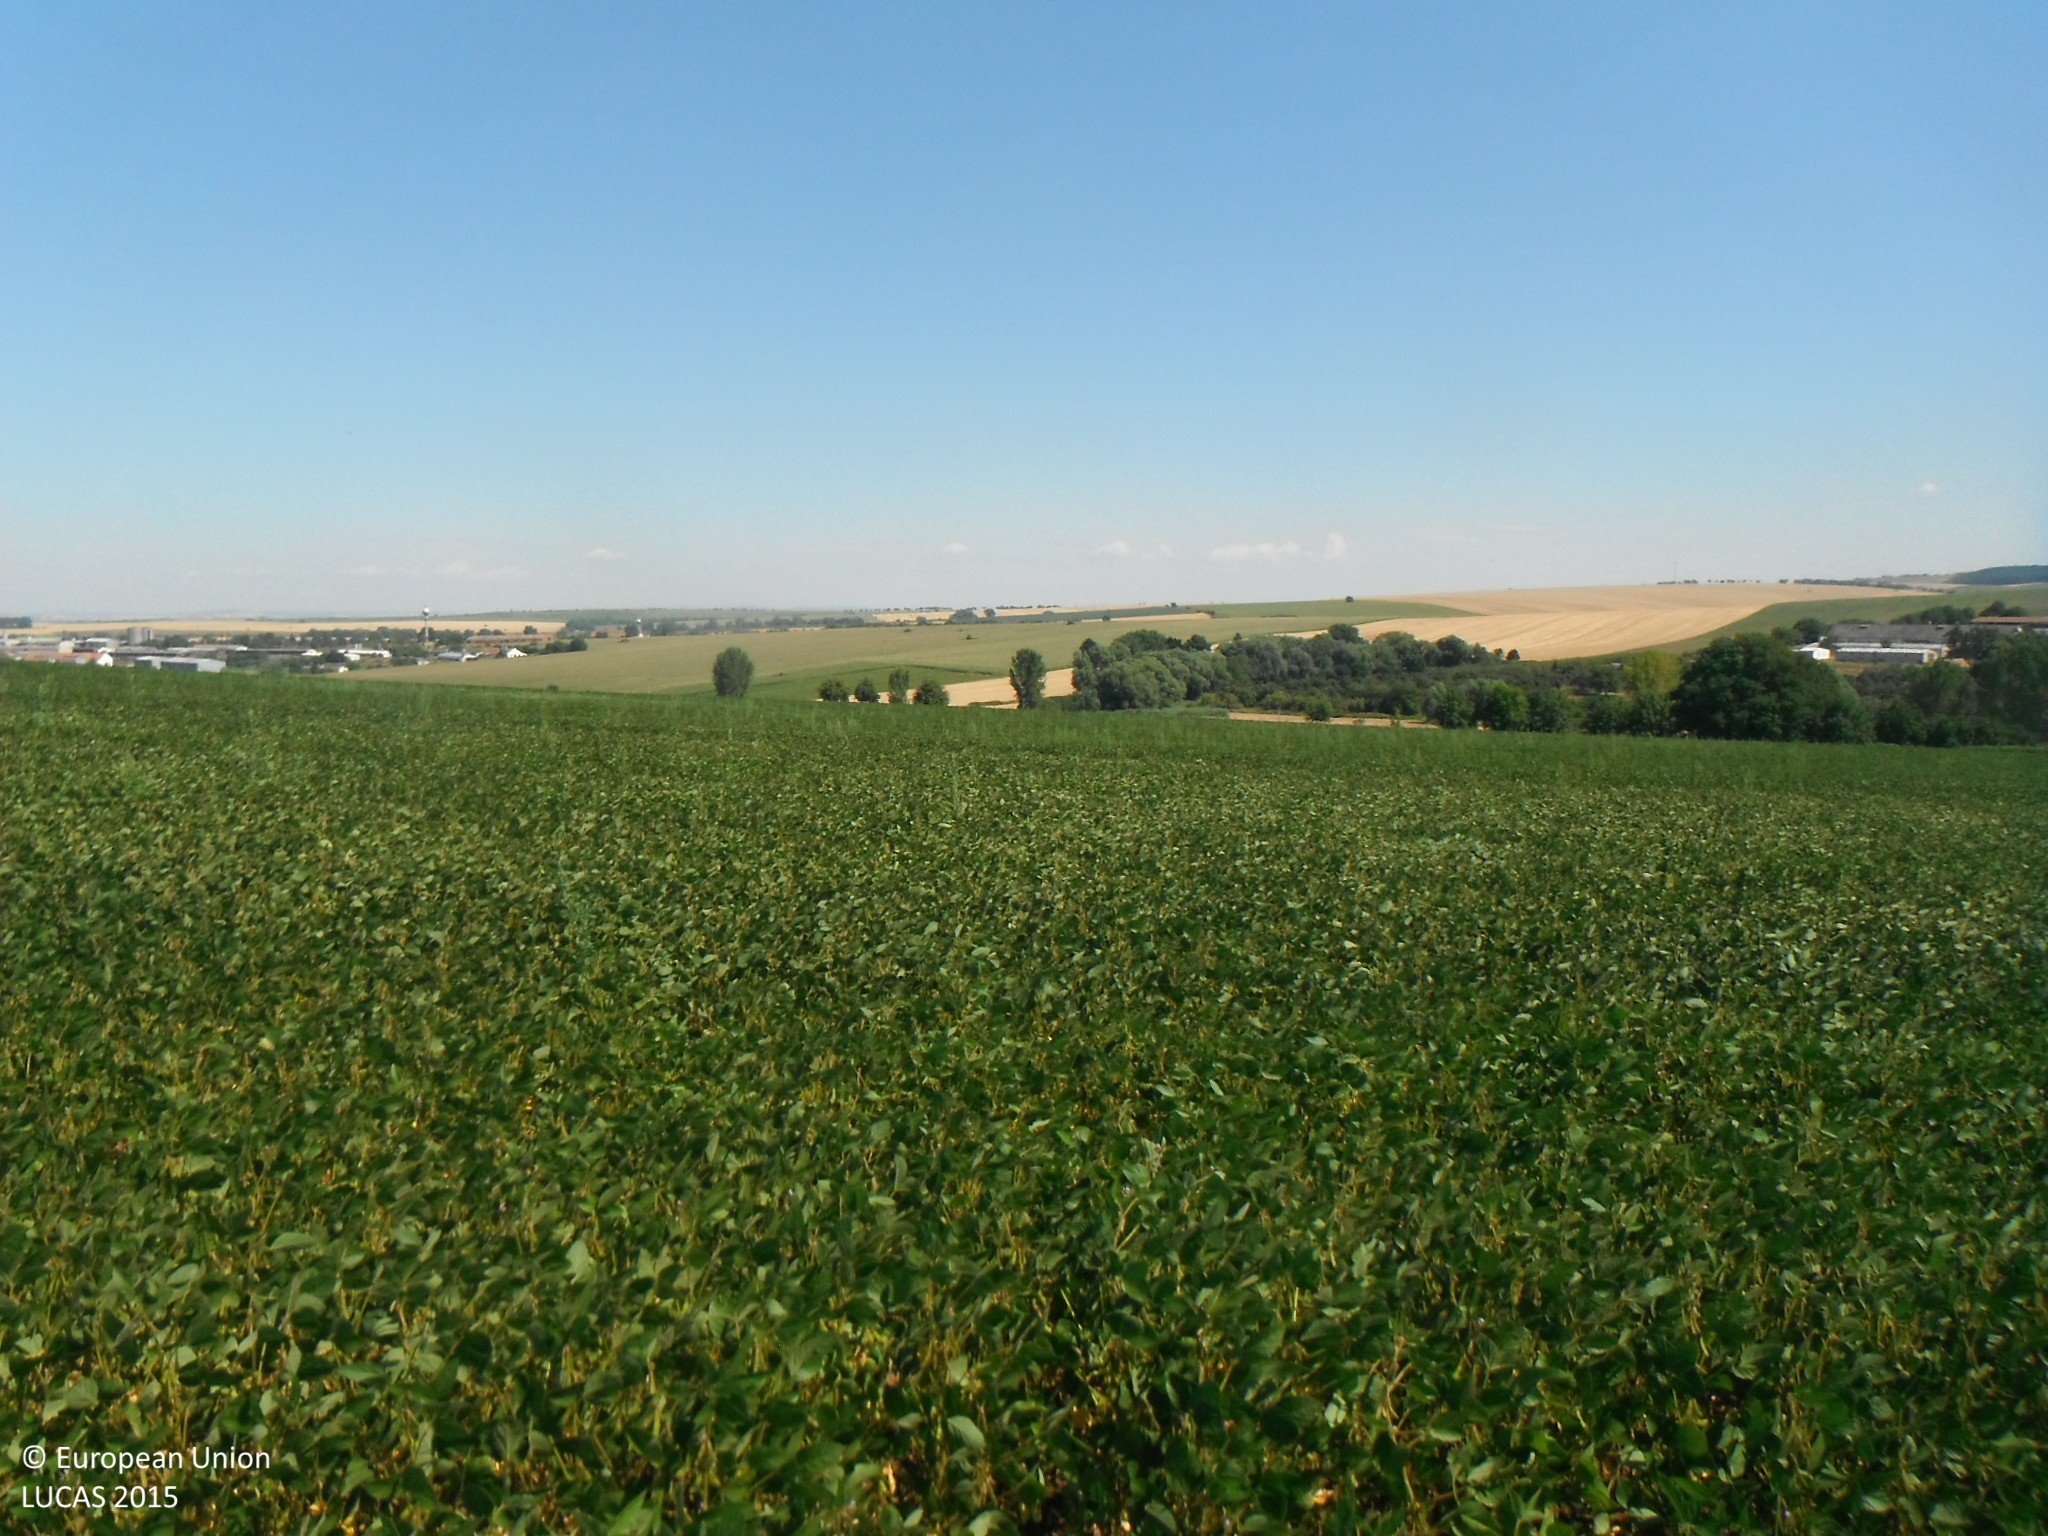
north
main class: Cropland
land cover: Soya
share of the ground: > 75 %
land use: Agriculture (excluding fallow land and kitchen gardens)
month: July
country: SK
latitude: 48.7124
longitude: 17.1716
